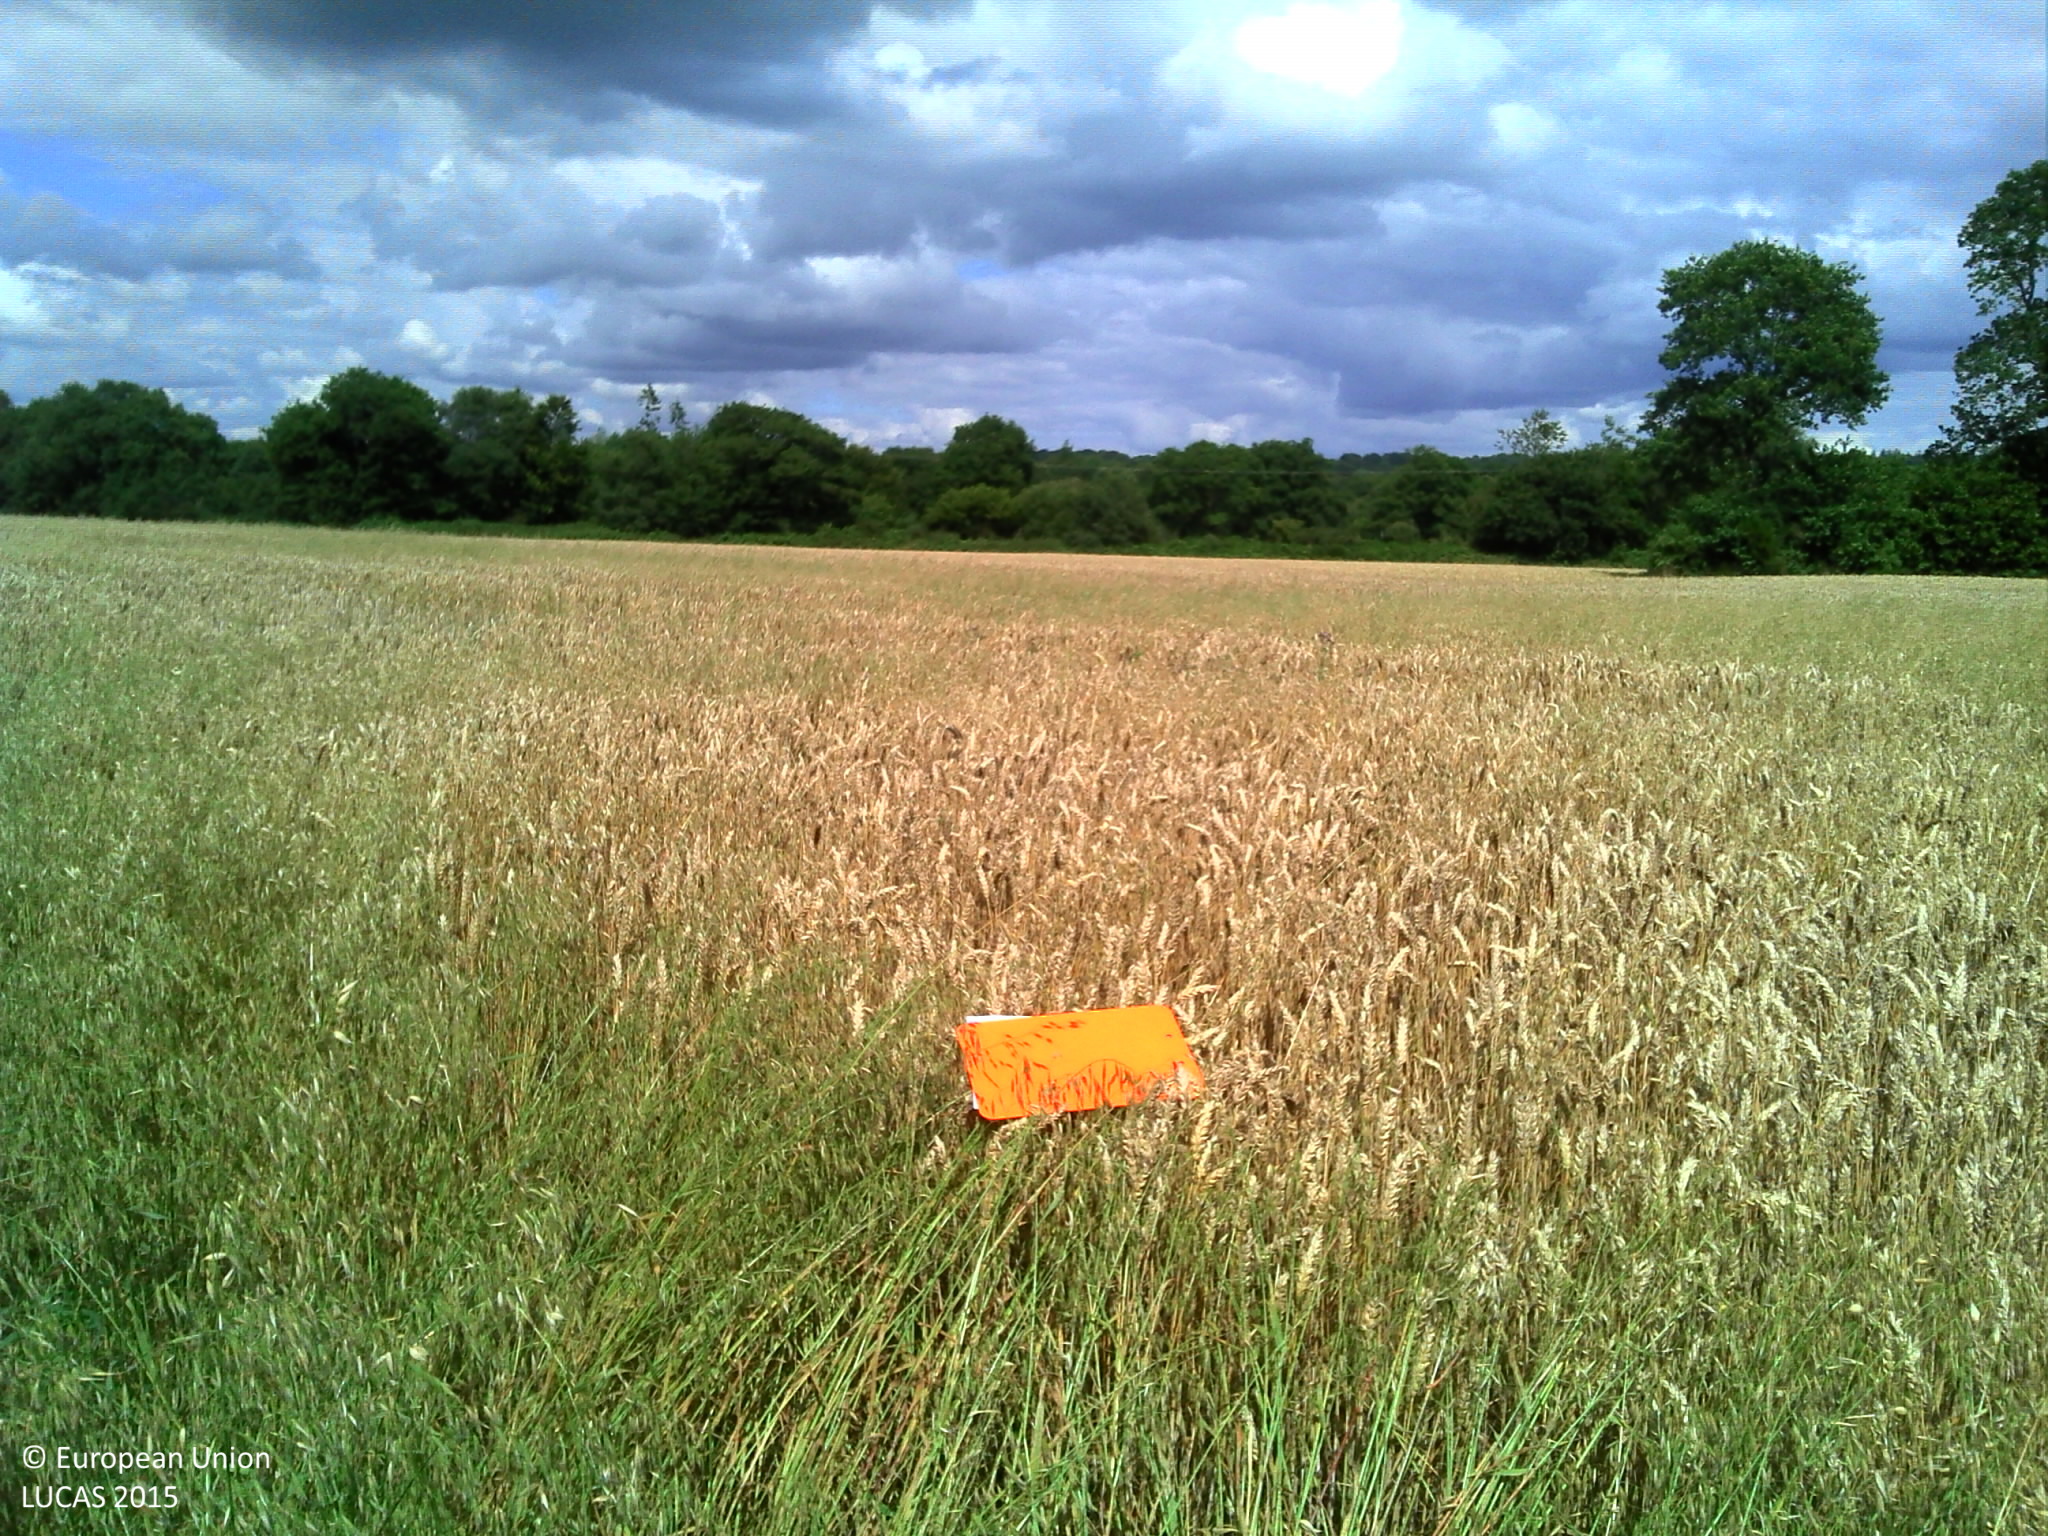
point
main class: Grassland
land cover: Grassland without tree/shrub cover
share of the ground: > 75 %
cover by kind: herbaceous plants 100 %
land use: Agriculture (excluding fallow land and kitchen gardens)
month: July
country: FR
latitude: 48.1701
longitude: -3.3740
